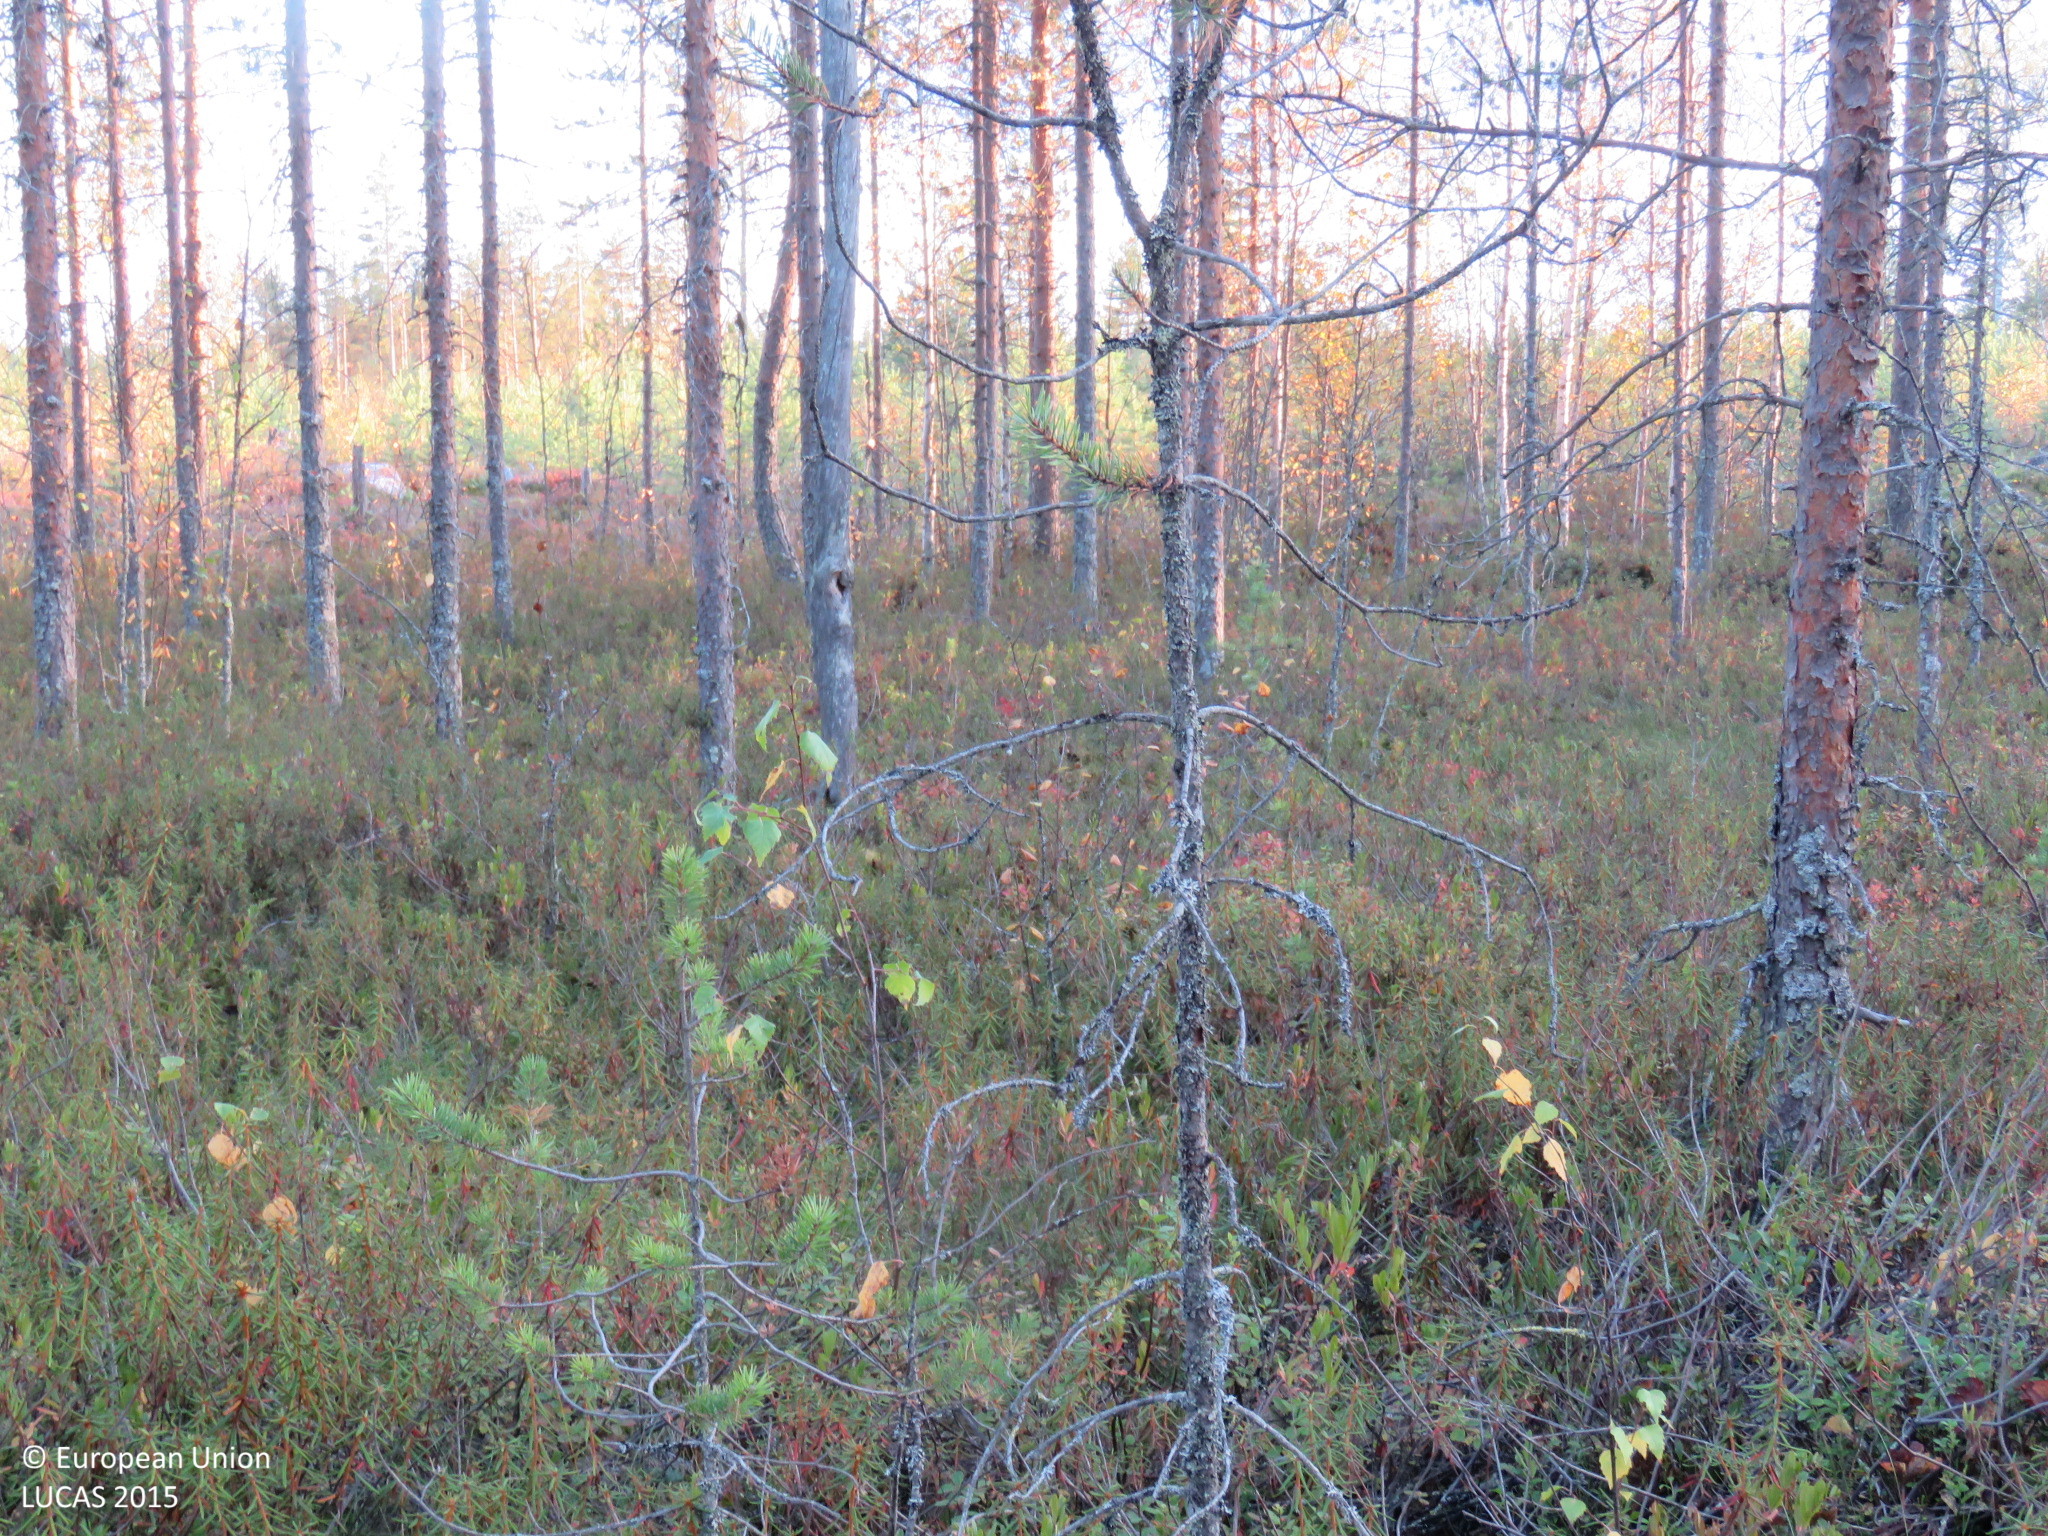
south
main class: Woodland
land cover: Pine dominated coniferous woodland
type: mire and swamp forests
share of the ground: > 75 %
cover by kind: coniferous forest trees 70 %, shrubs 15 %, broadleaved forest trees 5 %, herbaceous plants 5 %, lichens and mosses 5 %
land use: Forestry
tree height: > 5 m
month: September
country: FI
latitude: 65.0354
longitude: 26.7845
